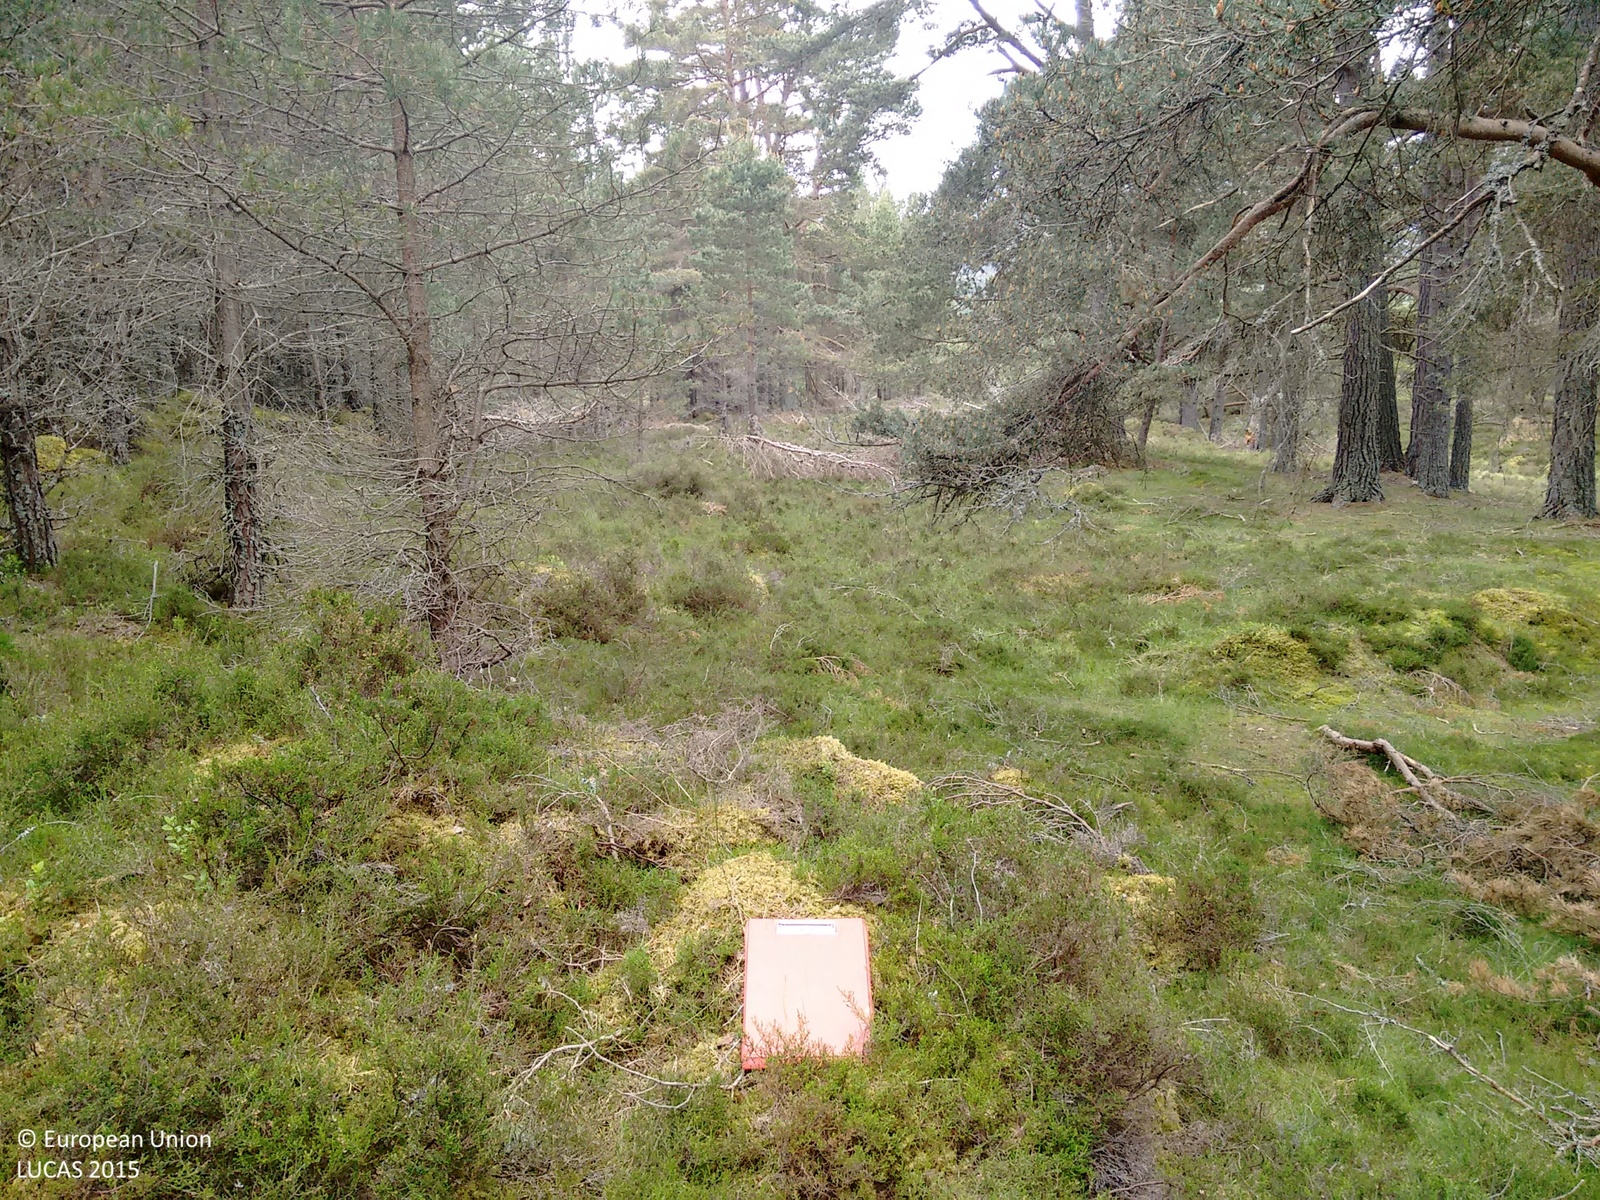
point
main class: Woodland
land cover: Pine dominated coniferous woodland
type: exotic forest
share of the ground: > 75 %
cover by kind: coniferous forest trees 85 %, herbaceous plants 10 %, lichens and mosses 5 %
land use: Semi-natural and natural areas not in use
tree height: > 5 m
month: June
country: GB
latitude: 57.0042
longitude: -3.3234
